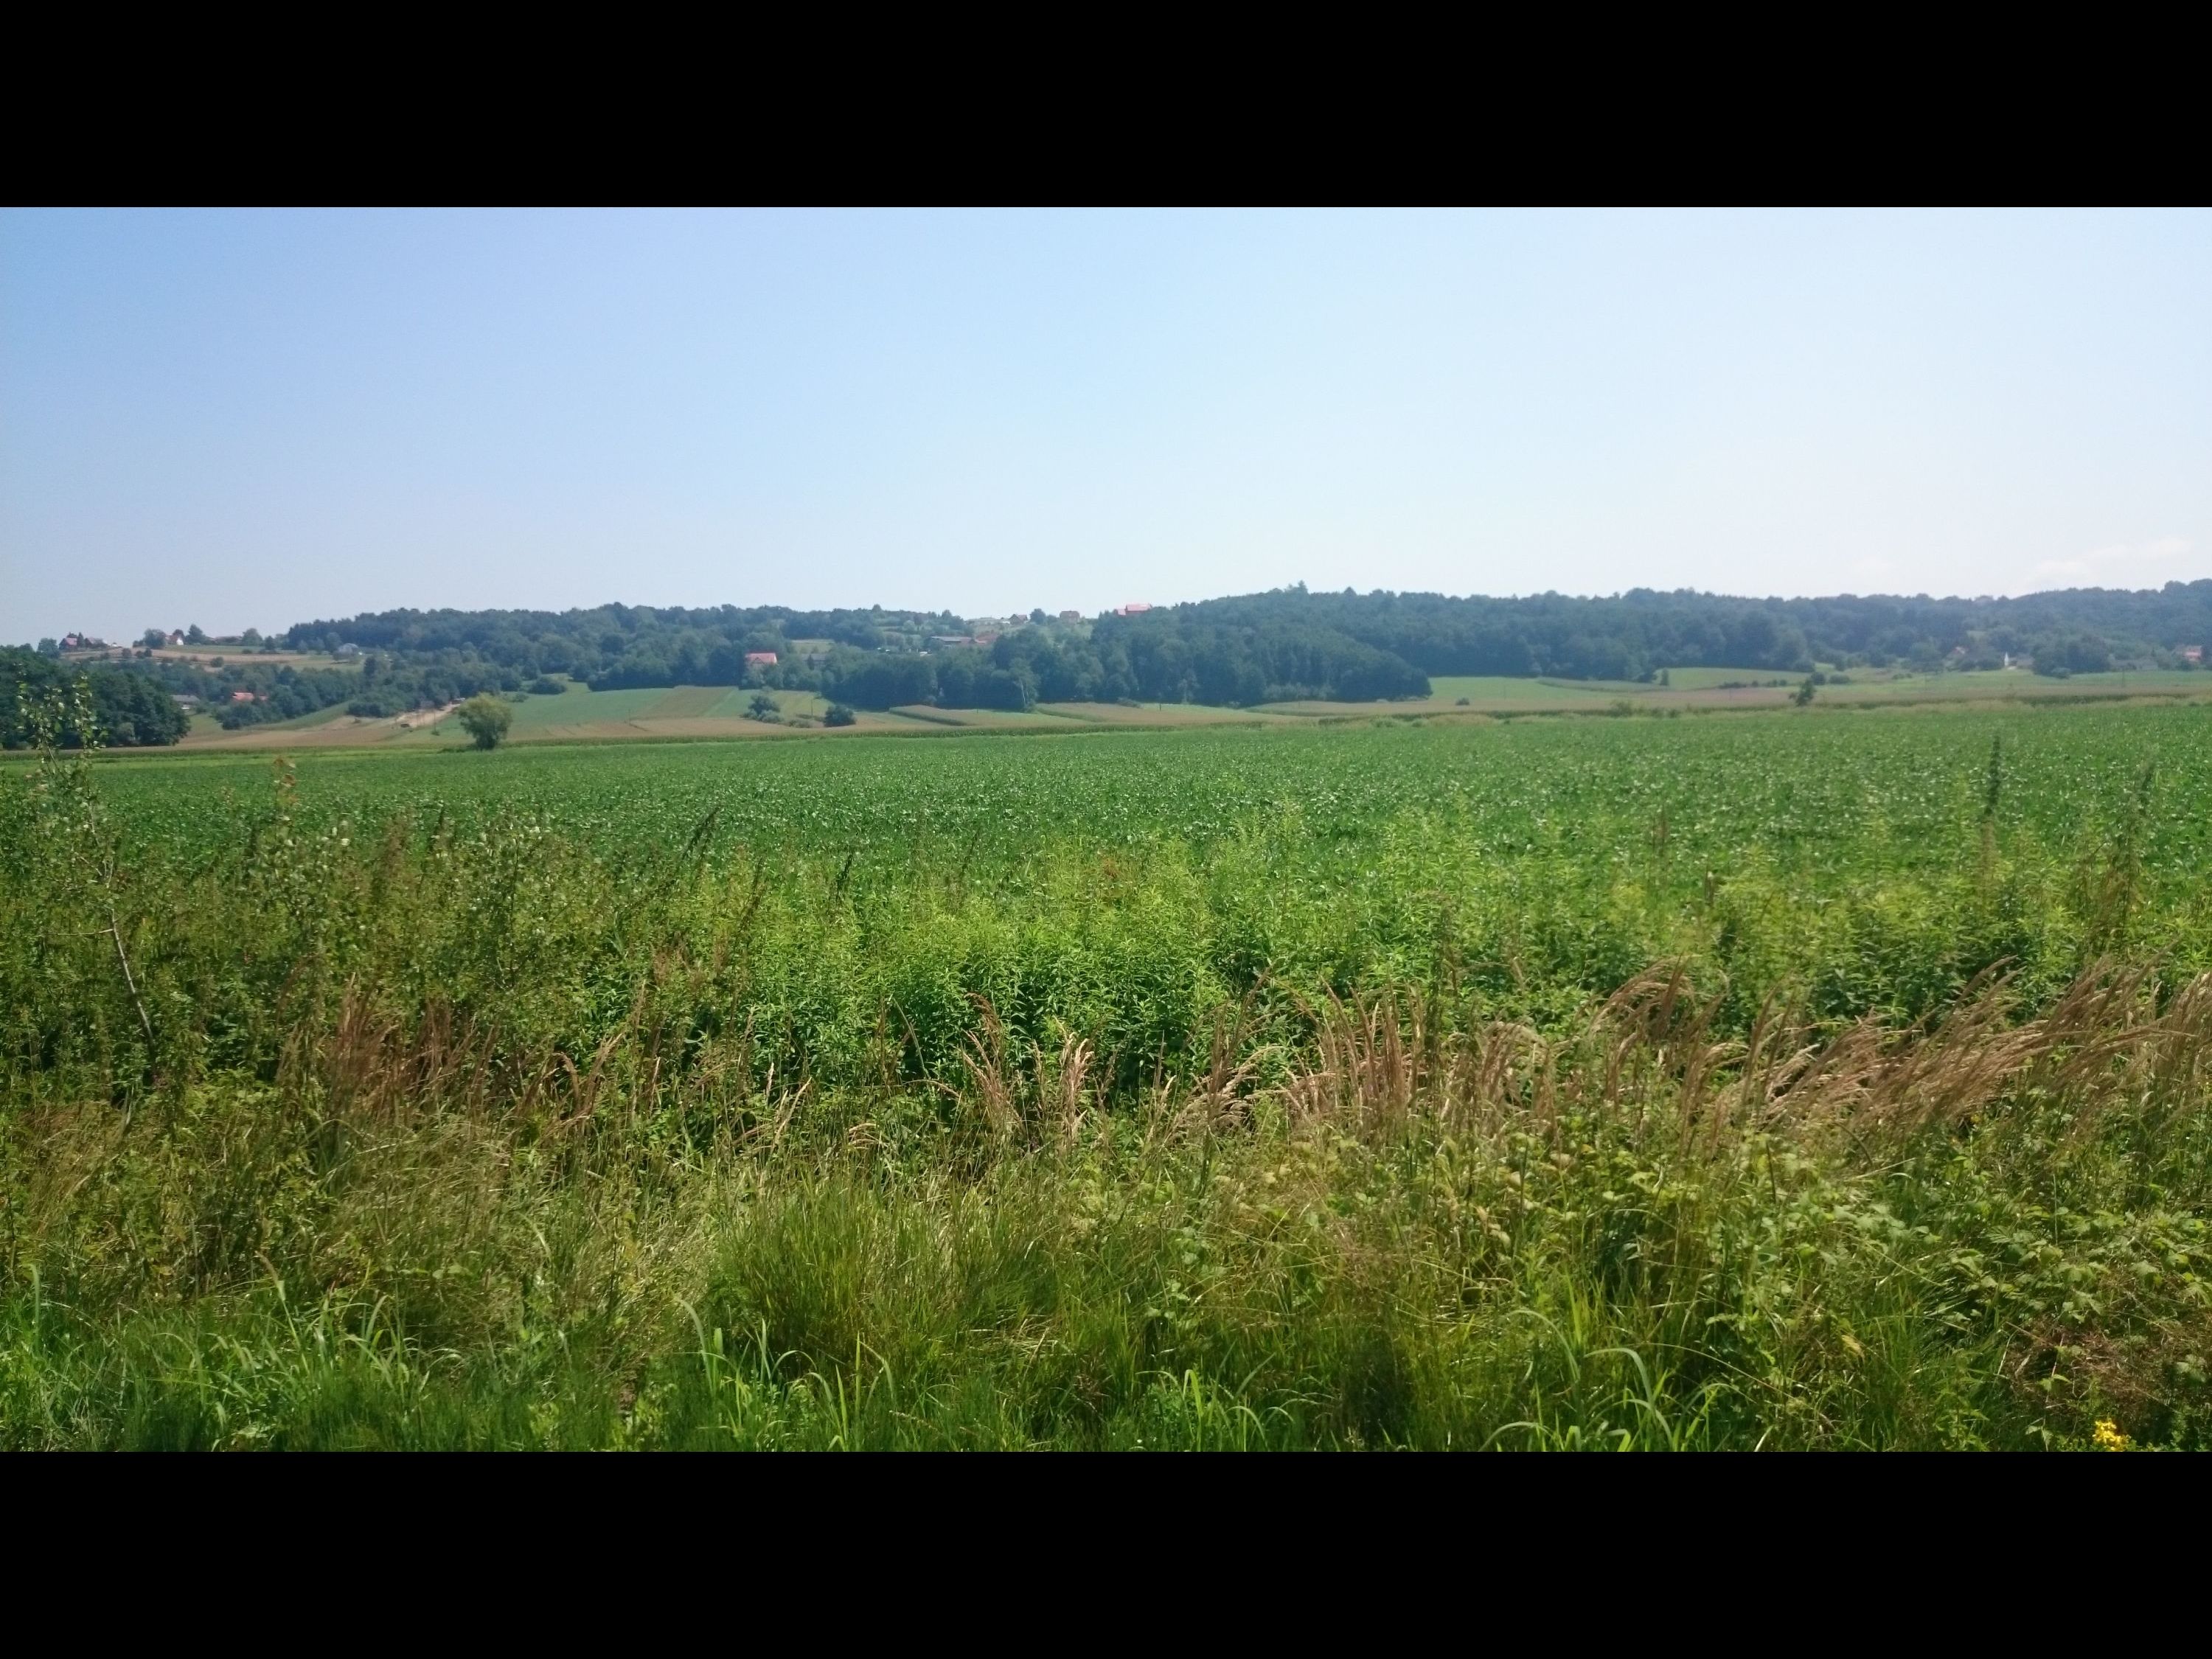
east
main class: Cropland
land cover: Soya
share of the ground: > 75 %
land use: Agriculture (excluding fallow land and kitchen gardens)
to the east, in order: Soya; Tracks; Soya; Grass margins; Tracks; Grass margins; Other fibre and oleaginous crops
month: July
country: AT
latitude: 47.0979
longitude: 16.1016
